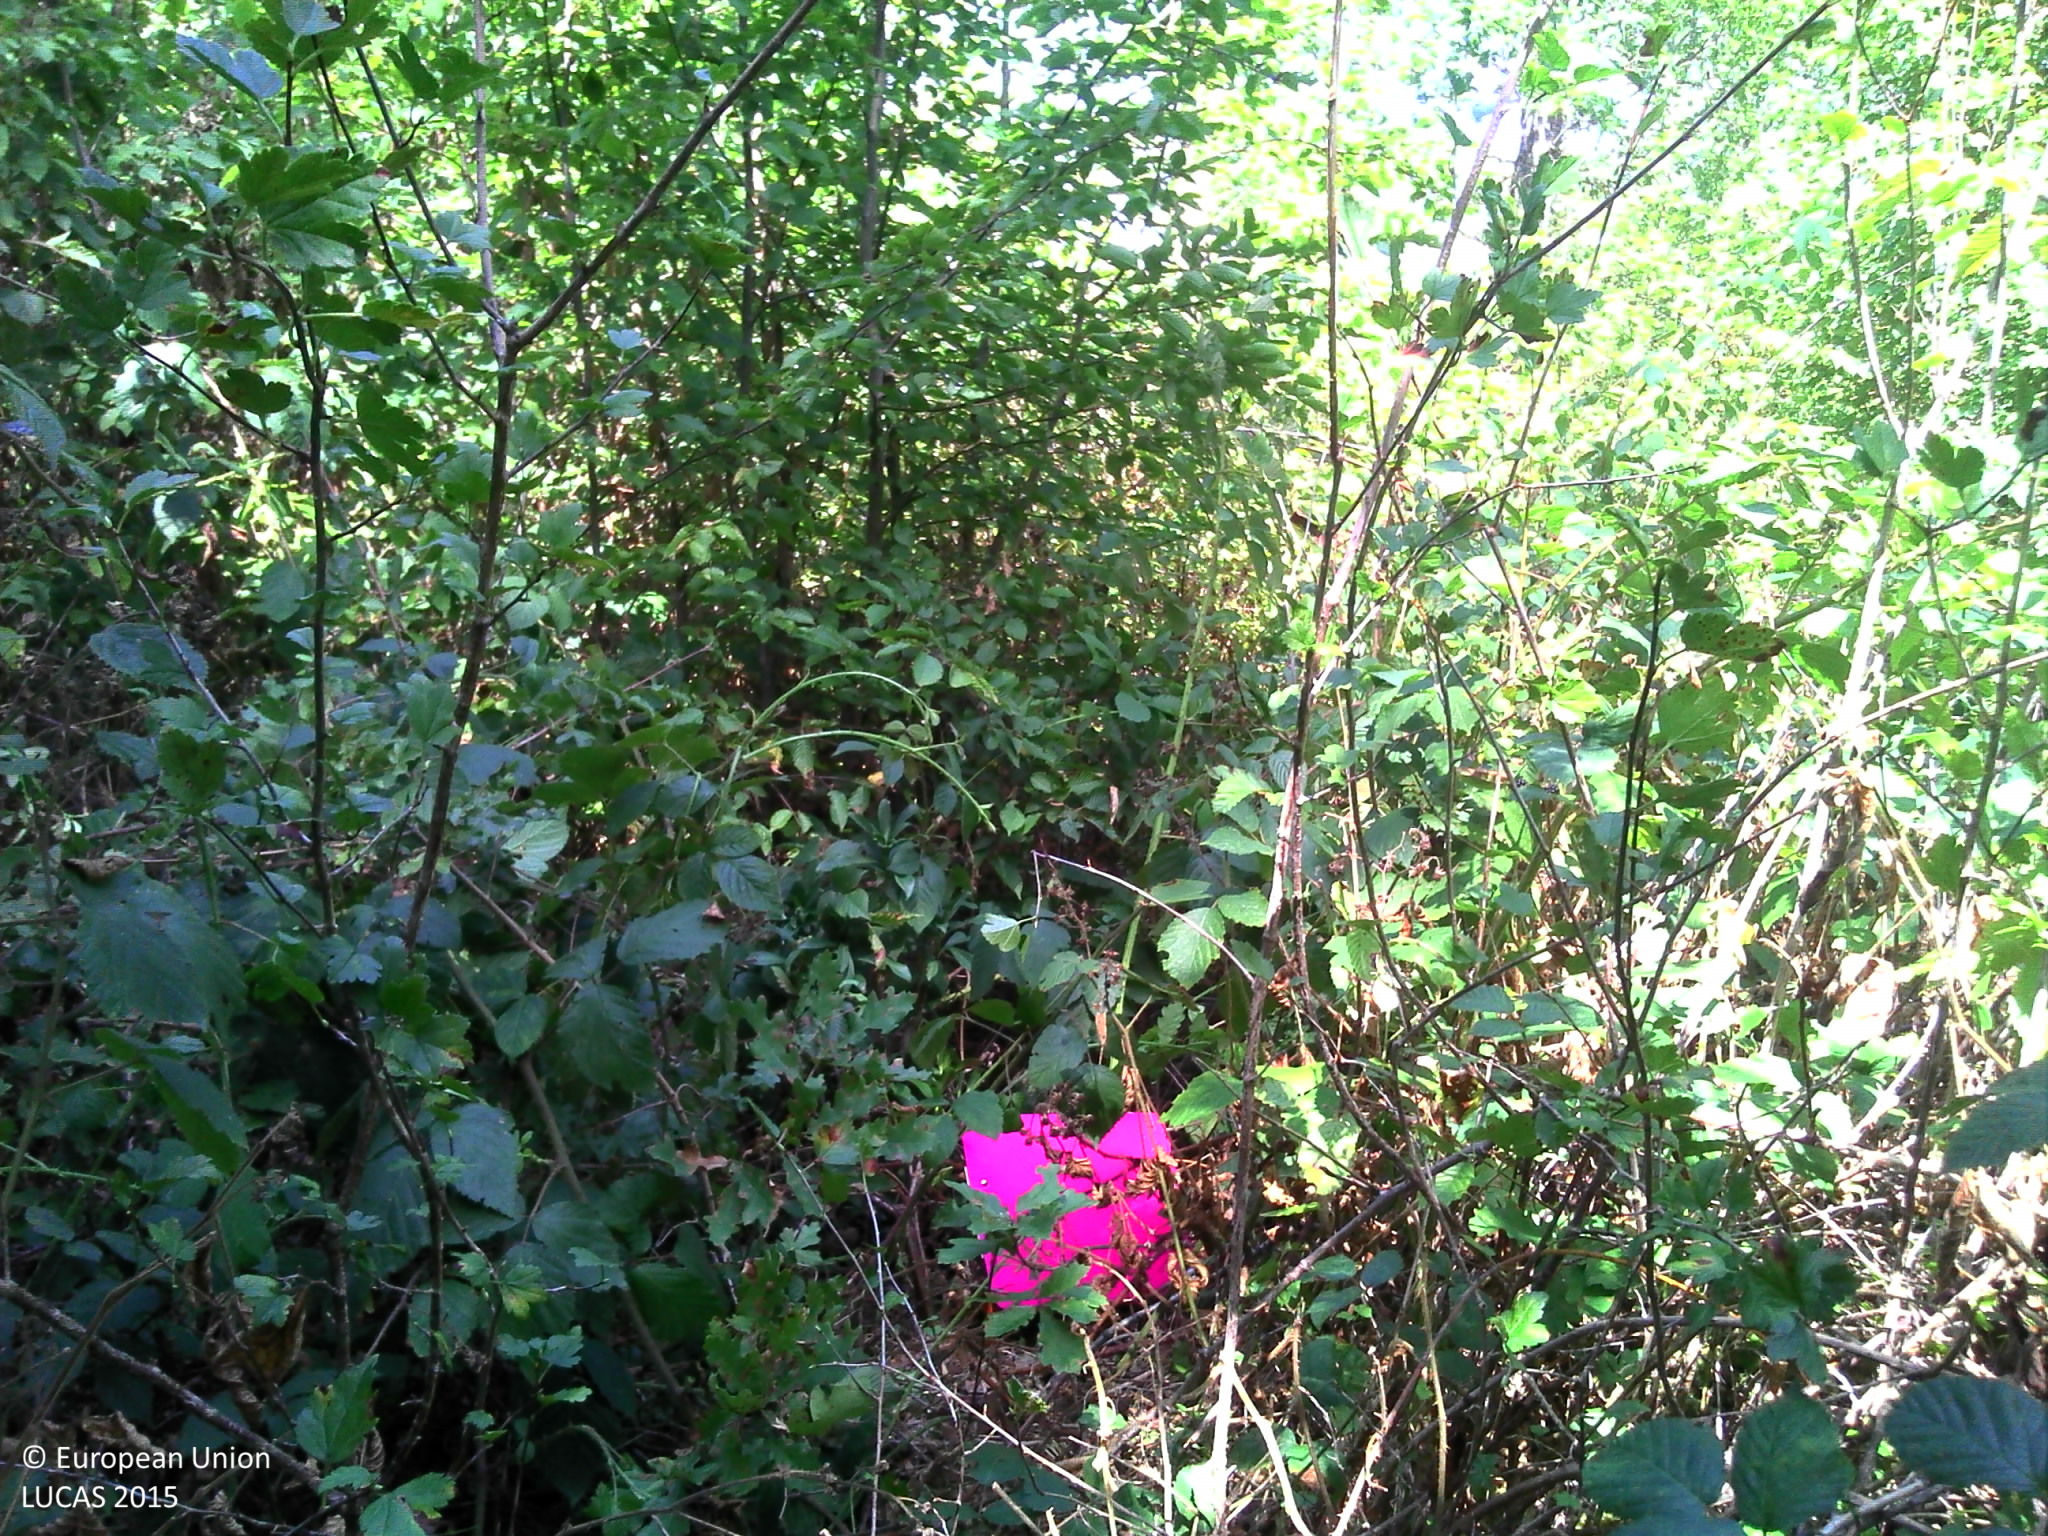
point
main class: Woodland
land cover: Broadleaved woodland
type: mesophytic deciduous forest
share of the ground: > 75 %
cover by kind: broadleaved forest trees 70 %, shrubs 20 %, herbaceous plants 10 %
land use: Forestry
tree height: > 5 m
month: August
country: FR
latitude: 47.2177
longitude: 4.8108
